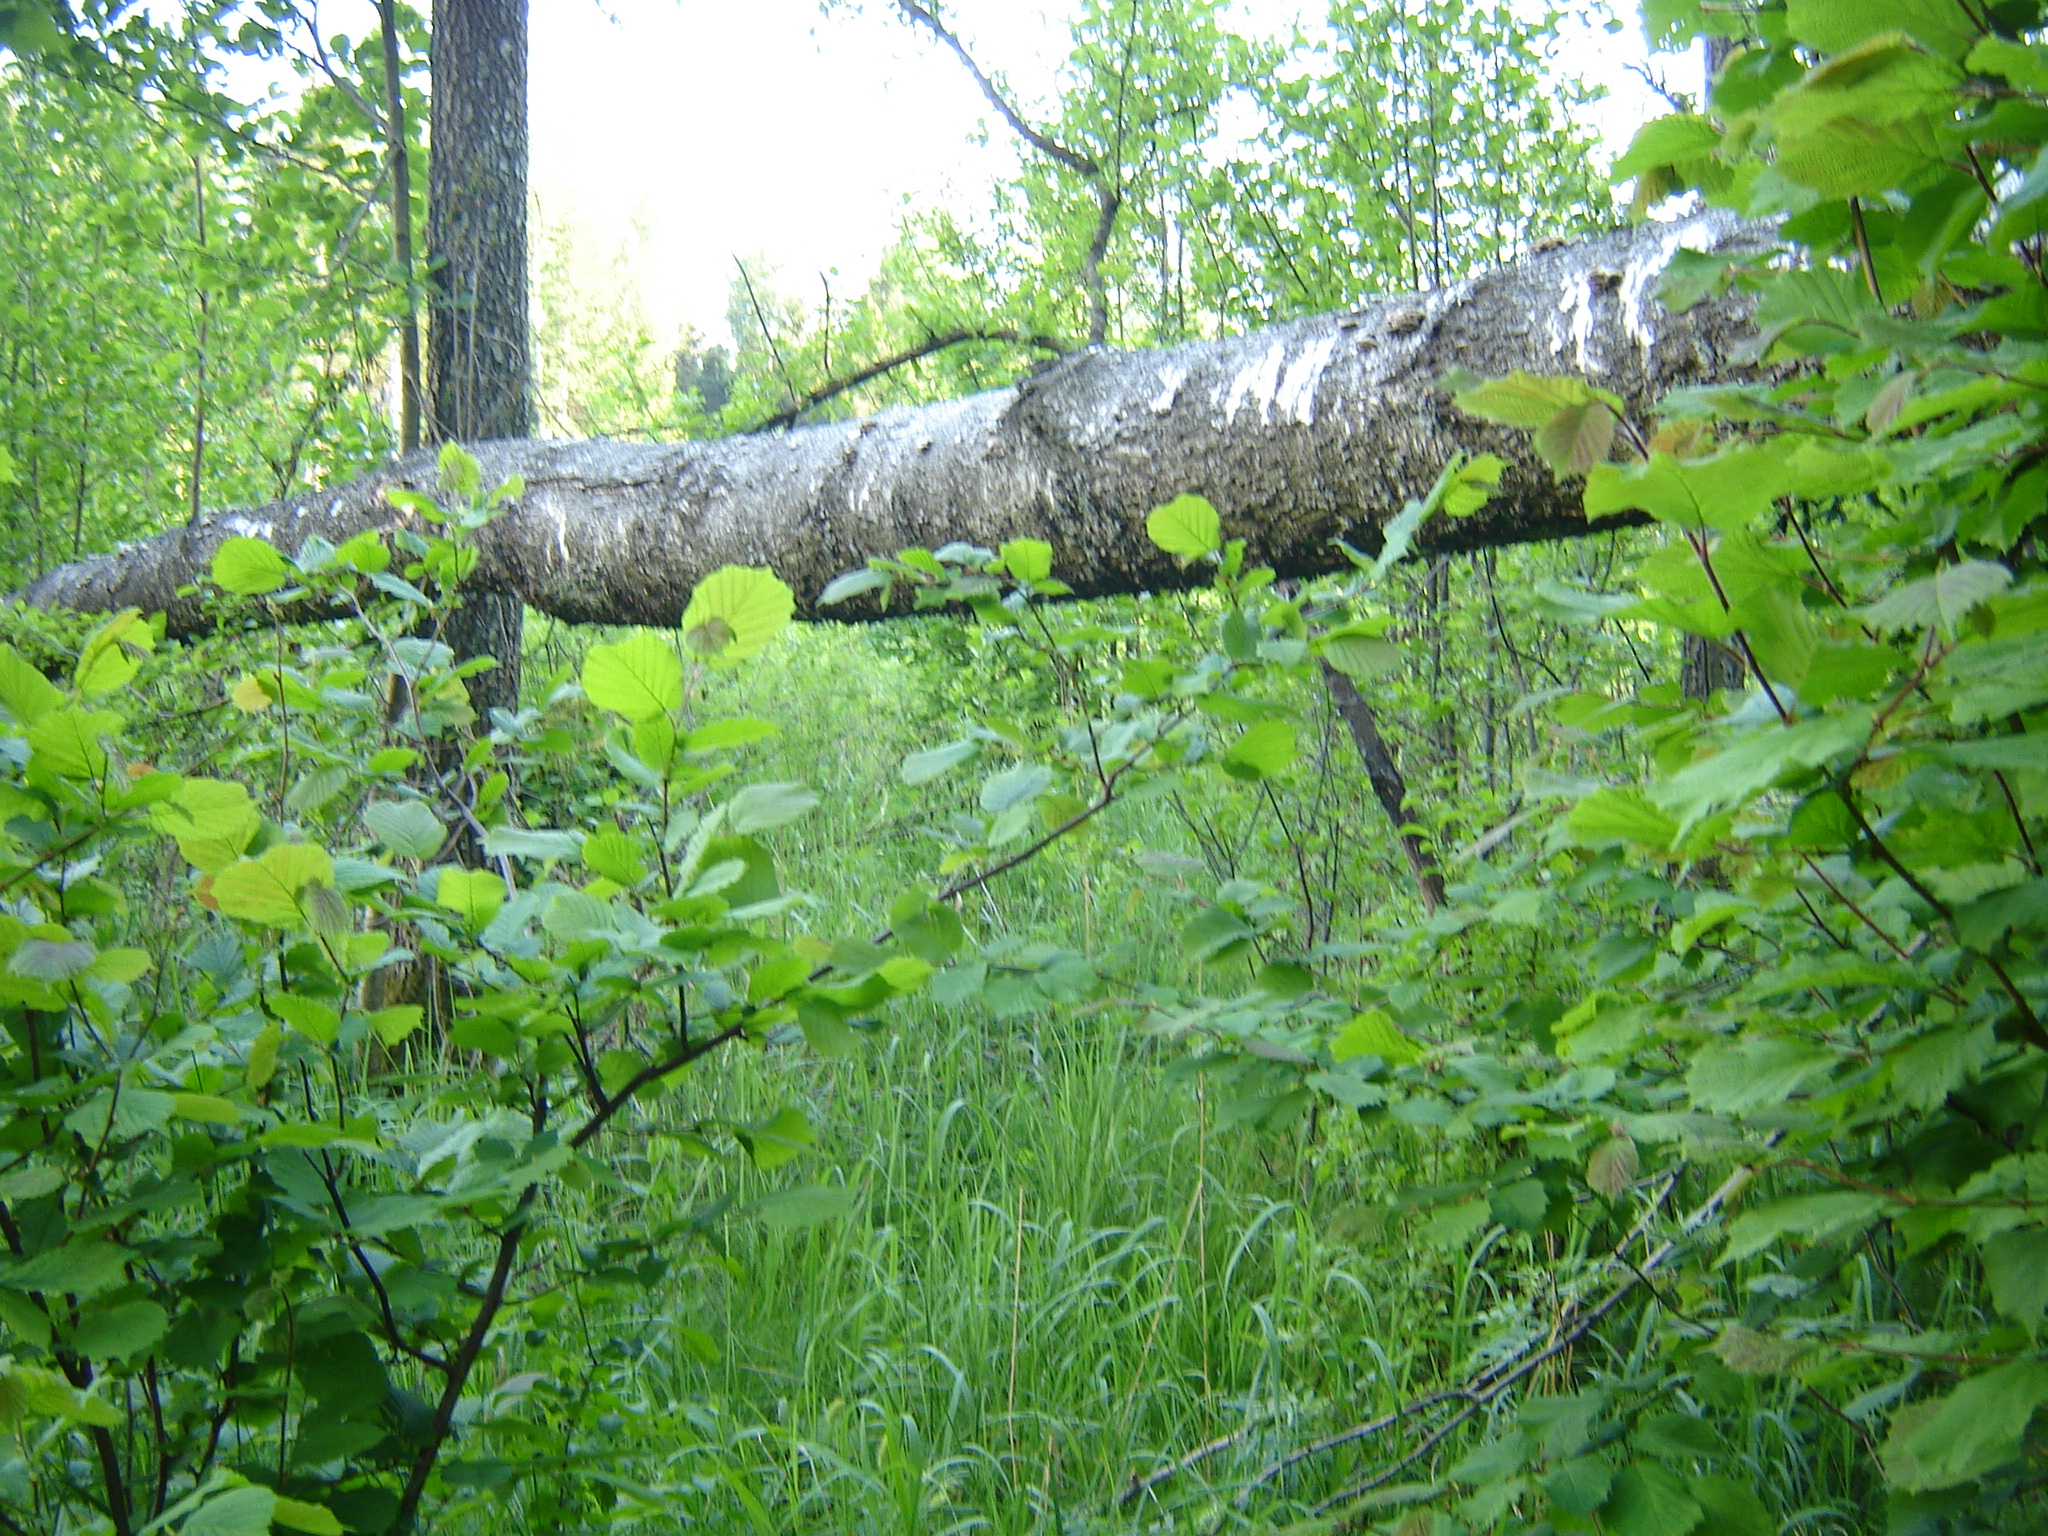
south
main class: Woodland
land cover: Spruce dominated mixed woodland
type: hemiboreal forest and nemoral coniferous forest and mixed broadleaved-coniferous forest
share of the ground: > 75 %
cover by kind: coniferous forest trees 50 %, broadleaved forest trees 30 %, herbaceous plants 20 %
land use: Forestry
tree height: > 5 m
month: June
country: LT
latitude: 55.8619
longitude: 25.3458
